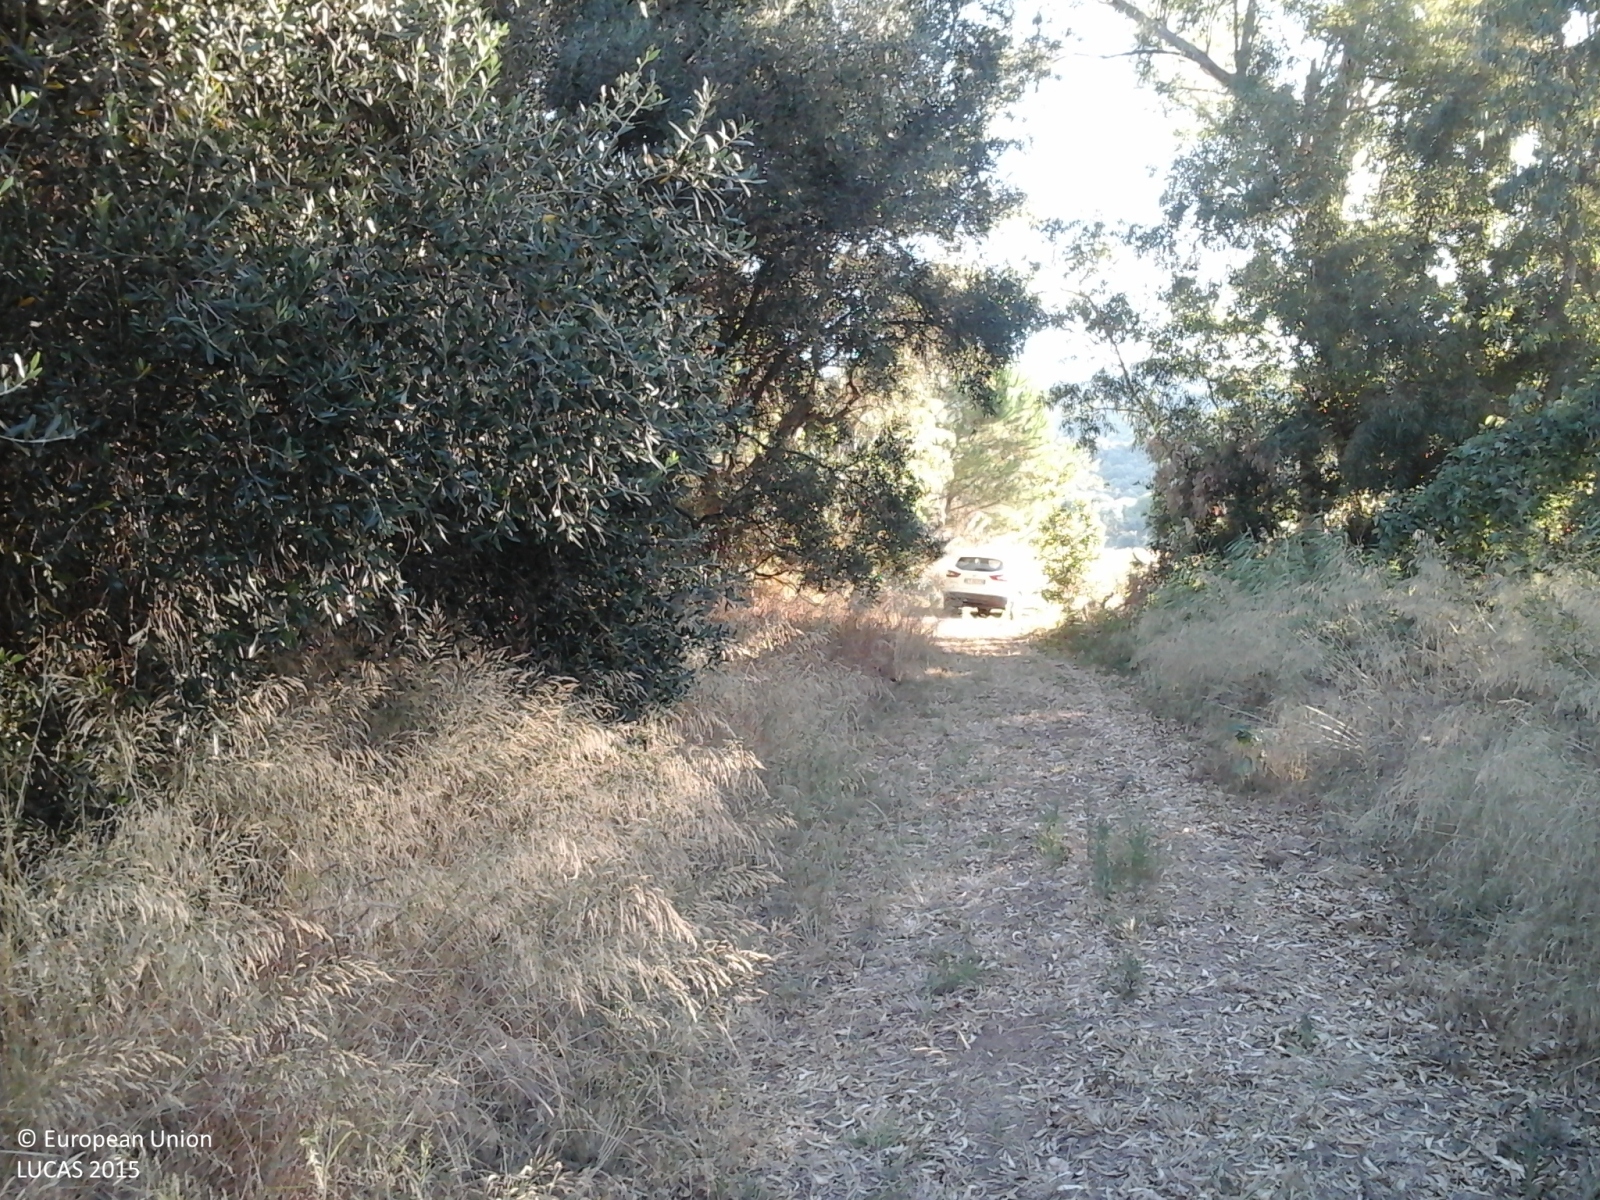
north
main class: Woodland
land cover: Pine dominated mixed woodland
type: broadleaved evergreen forest
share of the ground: > 75 %
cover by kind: coniferous forest trees 75 %, broadleaved forest trees 25 %
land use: Forestry
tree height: > 5 m
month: August
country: IT
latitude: 42.7770
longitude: 10.8406
